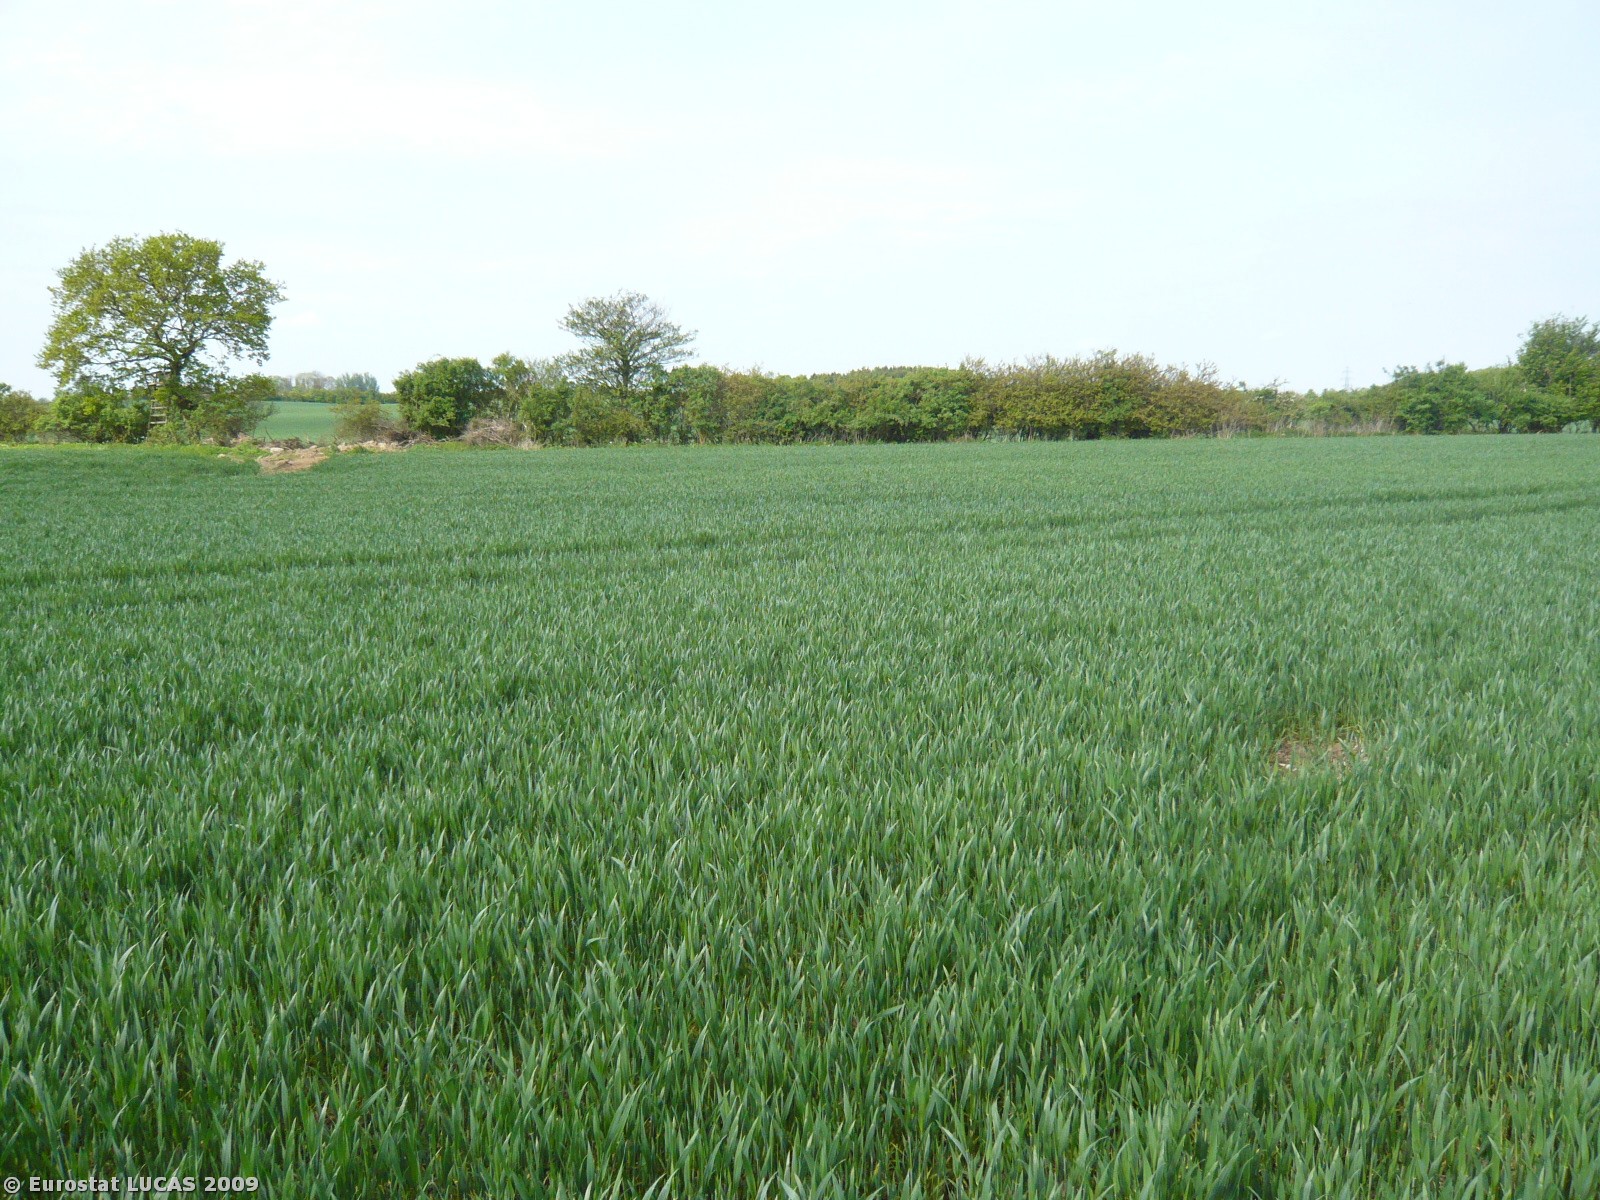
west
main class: Cropland
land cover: Common wheat
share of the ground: > 75 %
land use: Agriculture (excluding fallow land and kitchen gardens)
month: May
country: DK
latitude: 55.3271
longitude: 12.0002
